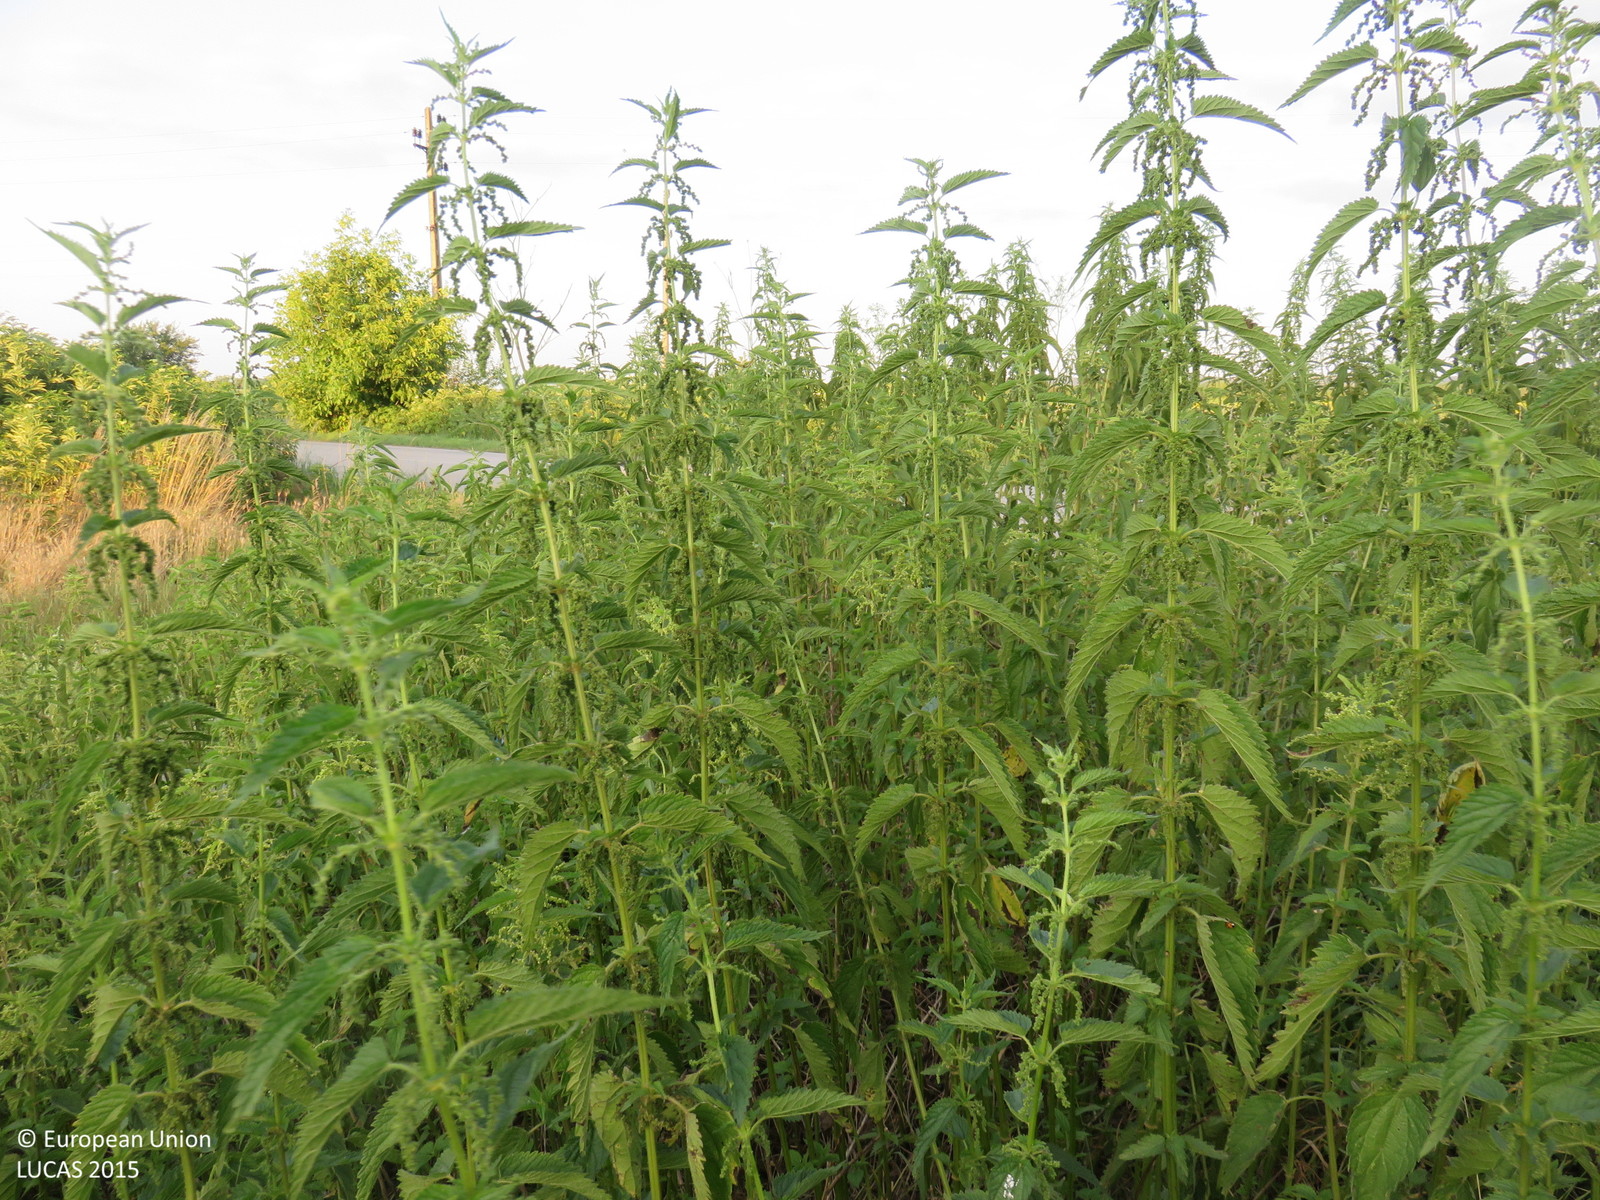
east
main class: Grassland
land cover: Grassland with sparse tree/shrub cover
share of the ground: > 75 %
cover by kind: herbaceous plants 95 %, broadleaved forest trees 5 %
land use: Agriculture (excluding fallow land and kitchen gardens)
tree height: > 5 m
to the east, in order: Grassland with sparse tree/shrub cover; Grass margins; Paved roads, cycling and walking lanes; Grass margins; Ditches and canals; Sunflower; Single bushes/trees; Electric lines; Sunflower; Electric lines; Sunflower; Grass margins
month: June
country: BG
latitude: 43.3148
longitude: 25.0762
